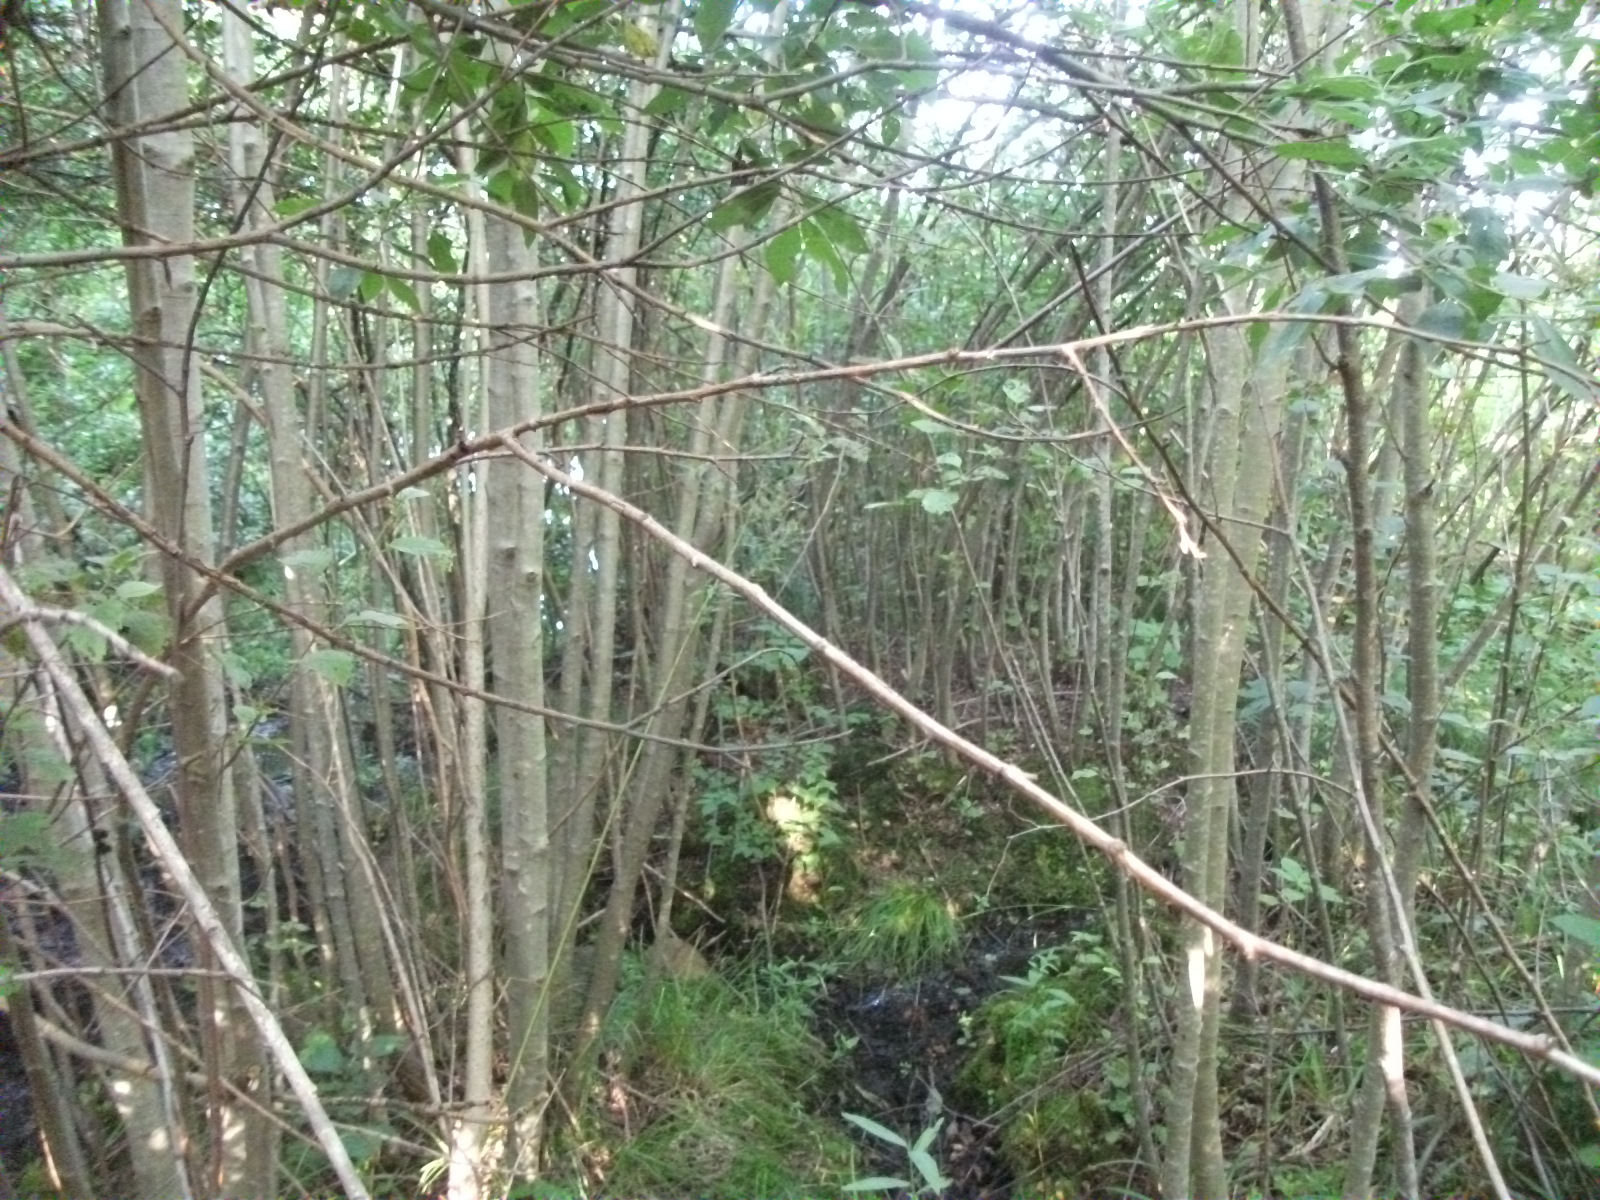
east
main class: Woodland
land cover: Broadleaved woodland
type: non-riverine alder, birch or aspen forest
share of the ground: > 75 %
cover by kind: broadleaved forest trees 95 %, shrubs 5 %
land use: Forestry
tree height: > 5 m
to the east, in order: Broadleaved woodland; Inland fresh water bodies; Abandoned hedges; Grassland without tree/shrub cover; Electric lines; Grassland without tree/shrub cover; Inland marshes; Grassland without tree/shrub cover; Abandoned hedges; Tracks; Shruby margins; Grassland without tree/shrub cover
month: August
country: LV
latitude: 56.8900
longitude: 26.2408
